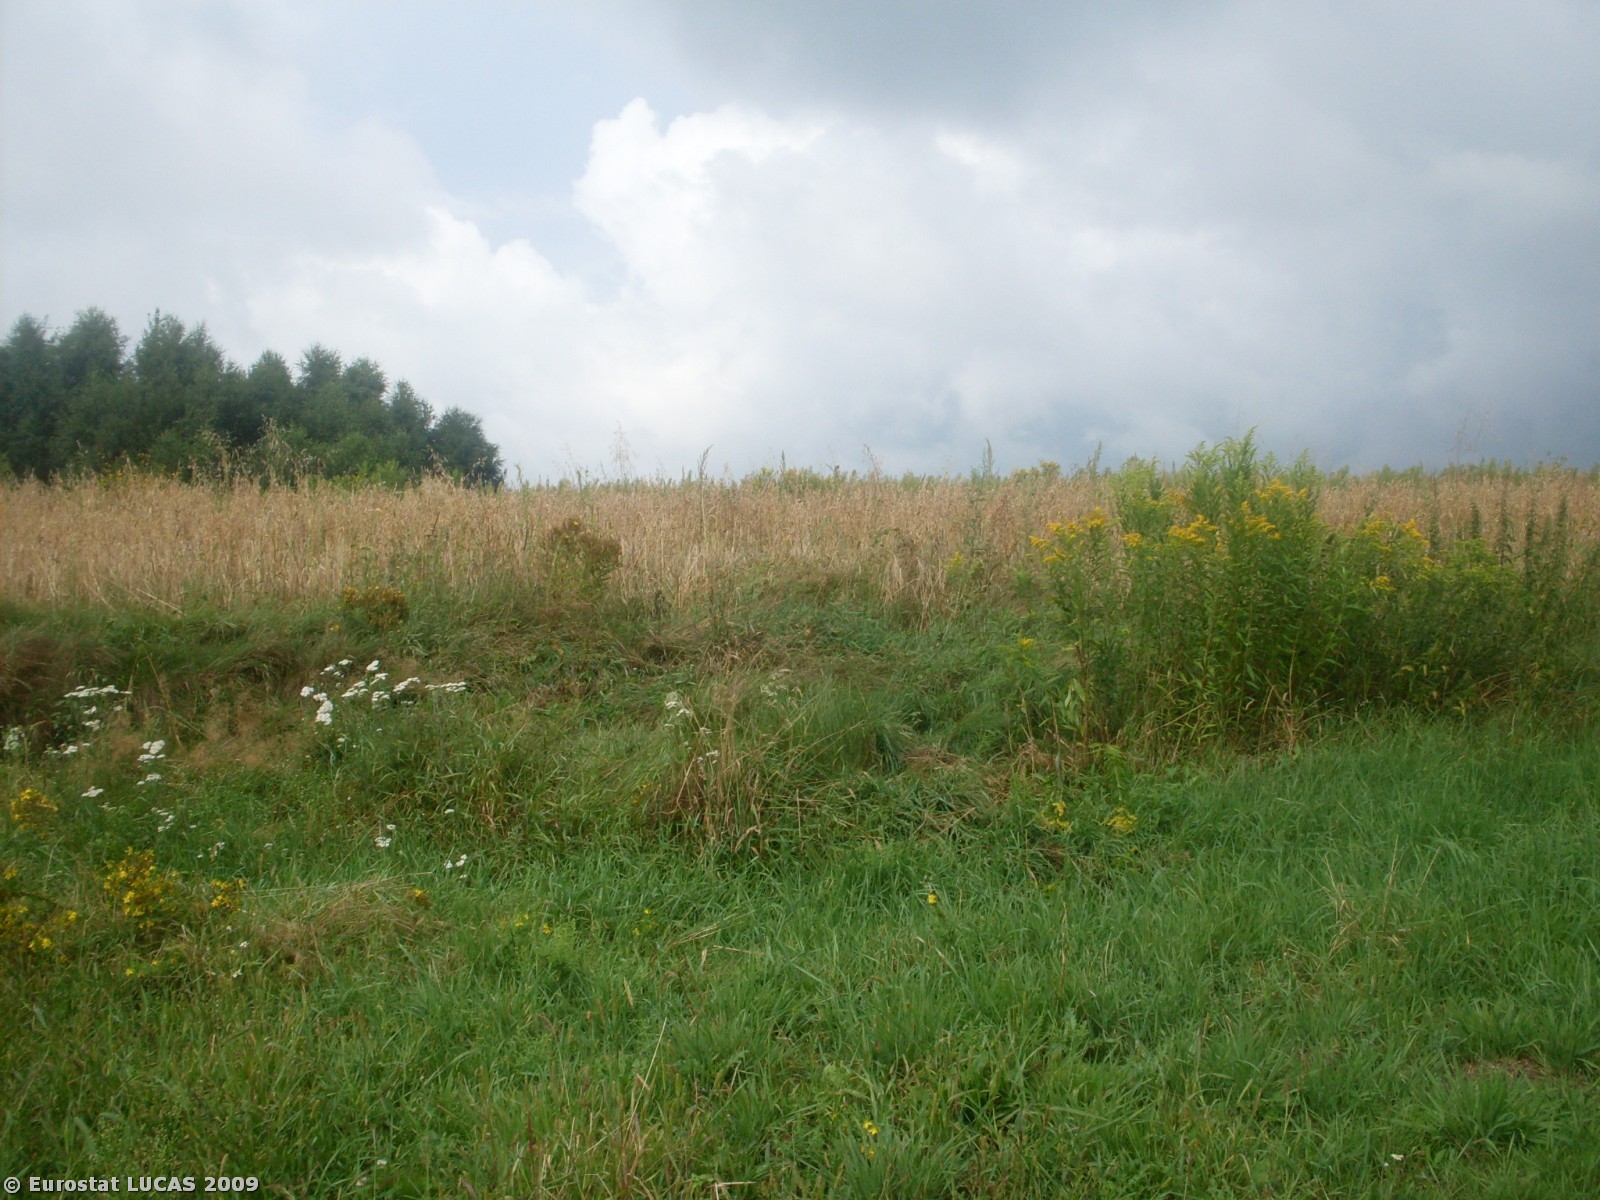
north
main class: Grassland
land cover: Grassland without tree/shrub cover
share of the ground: > 75 %
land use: Agriculture (excluding fallow land and kitchen gardens)
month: August
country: PL
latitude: 49.9821
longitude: 21.1323
